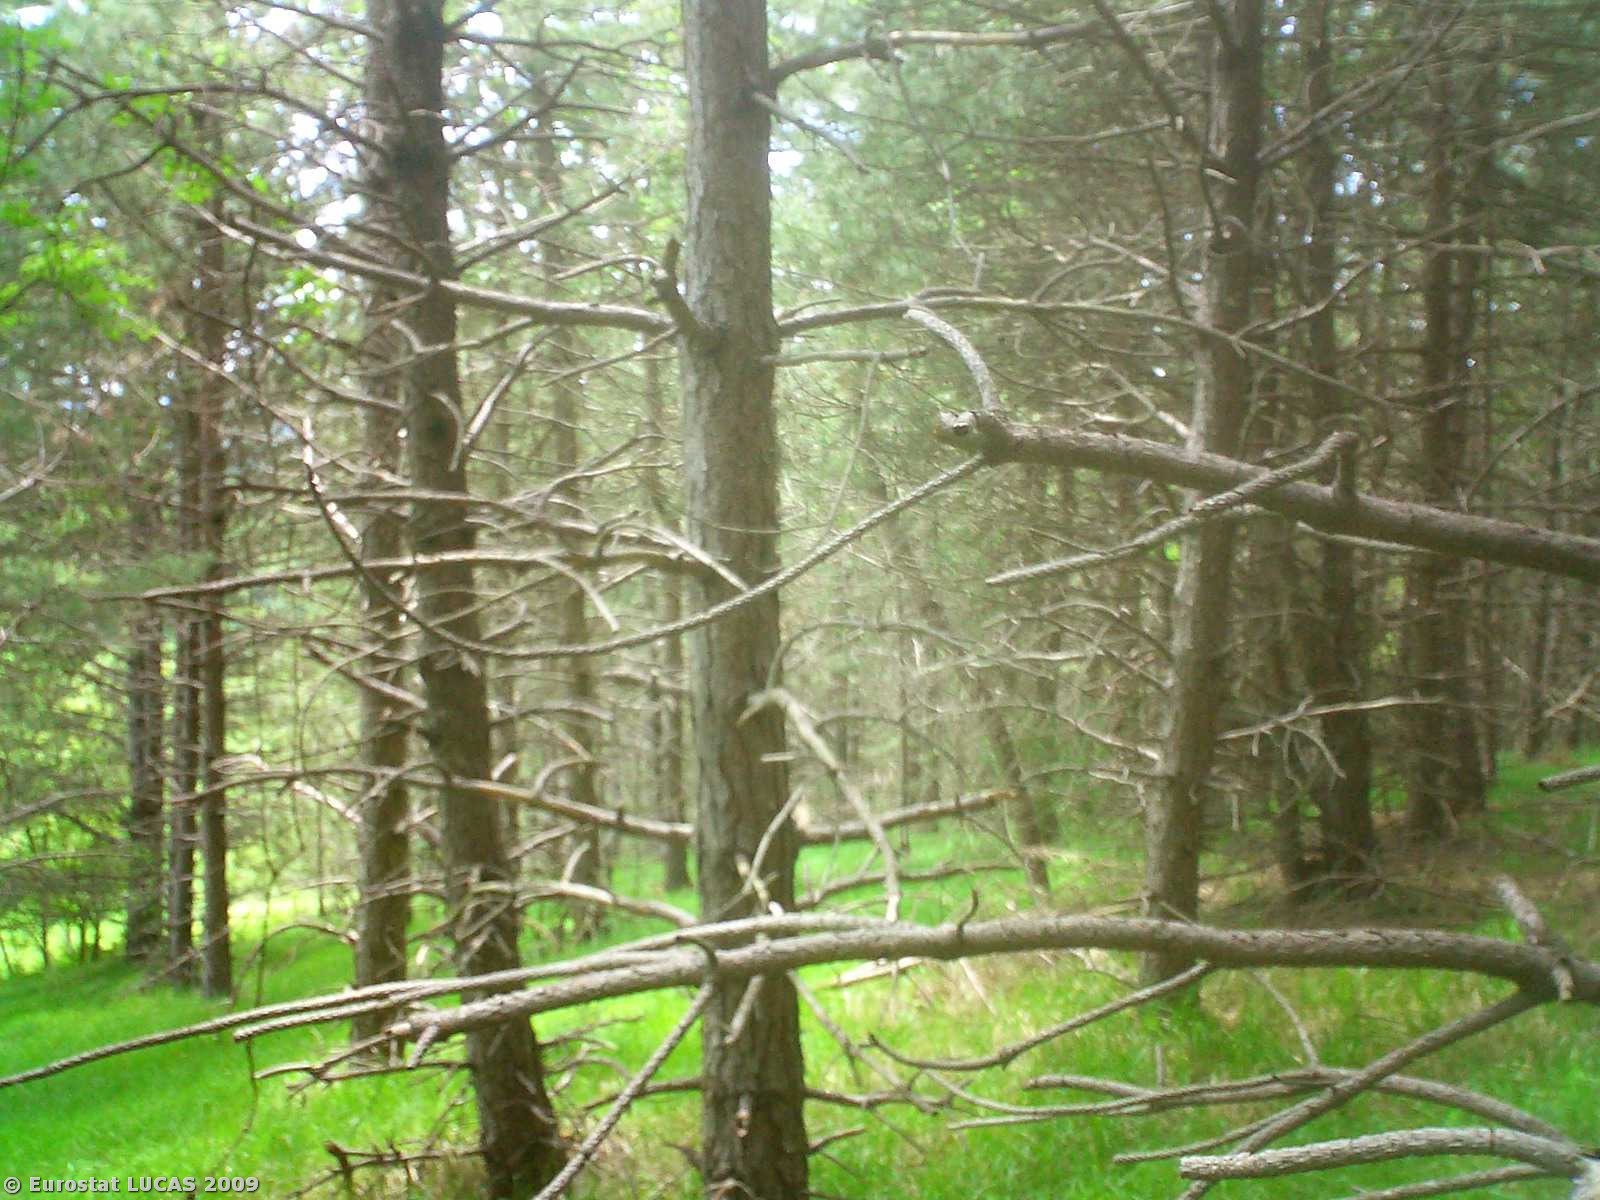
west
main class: Woodland
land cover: Coniferous woodland
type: alpine coniferous forest
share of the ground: 50 - 75 %
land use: Forestry
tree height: > 5 m
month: May
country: IT
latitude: 44.1392
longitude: 11.6337
